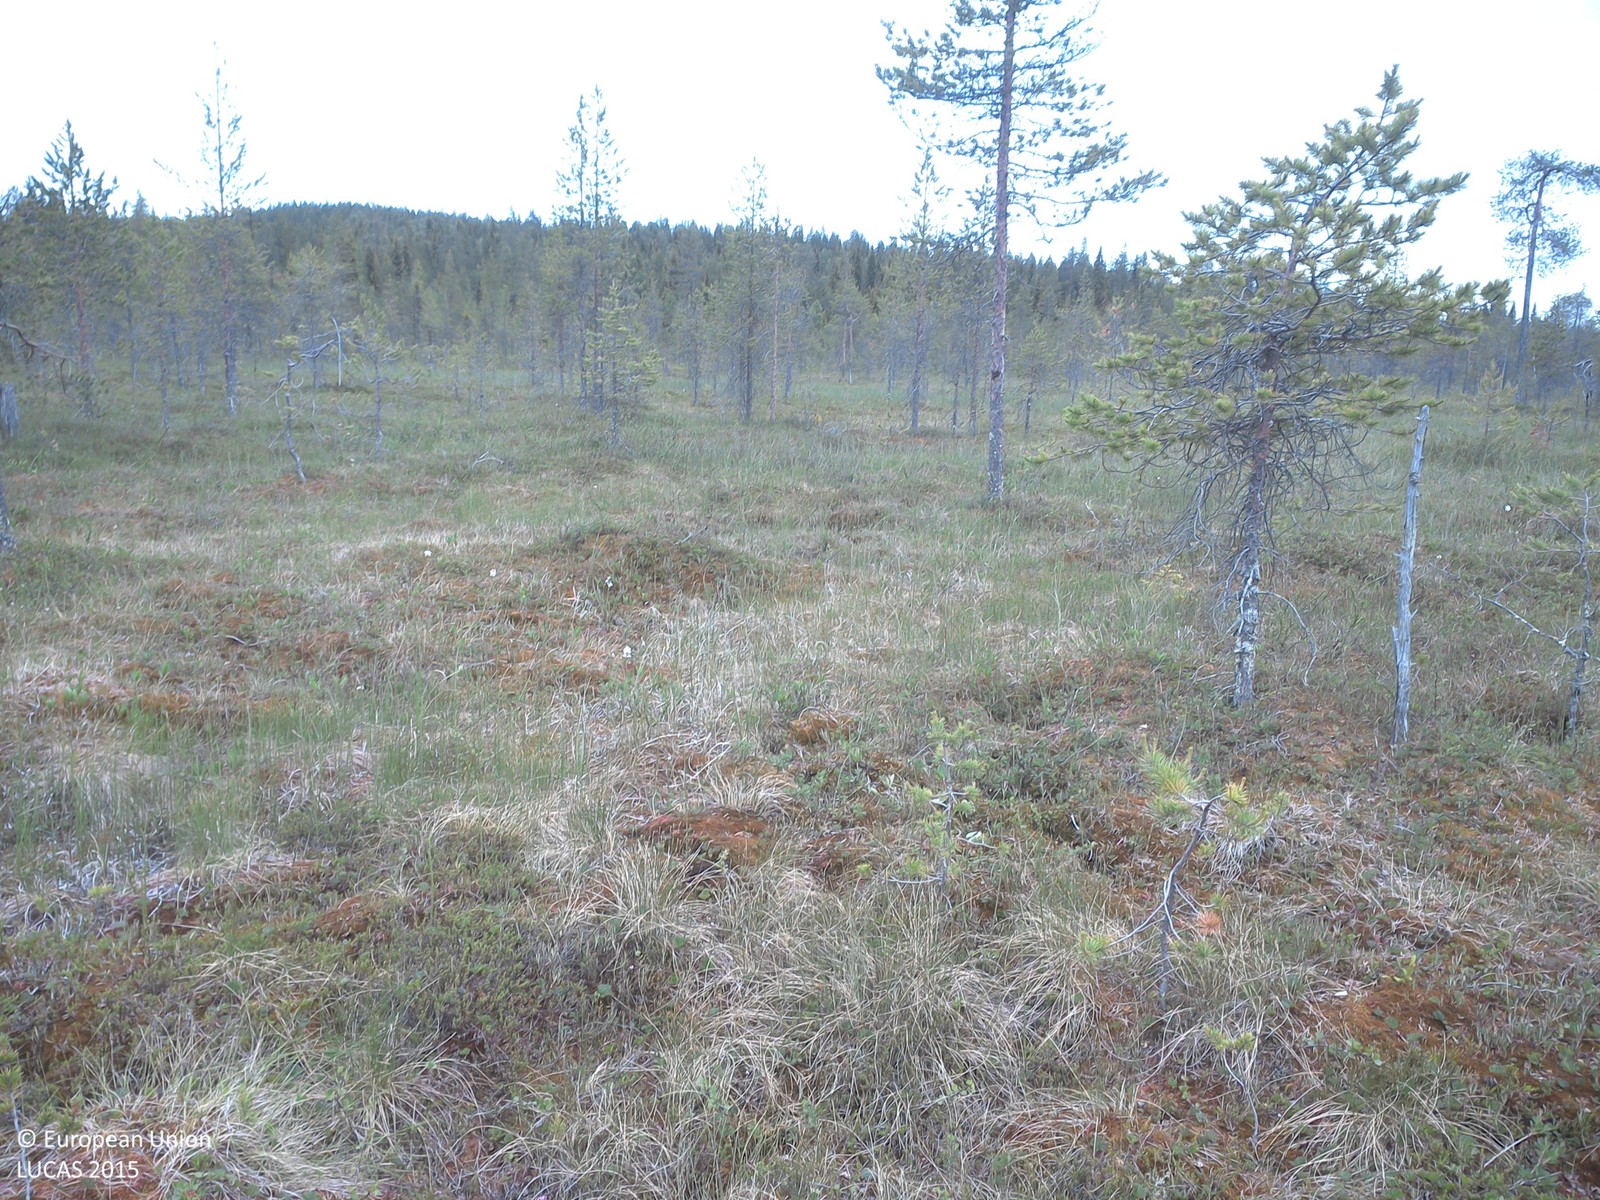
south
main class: Woodland
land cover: Pine dominated coniferous woodland
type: boreal forest
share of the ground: 10 - 25 %
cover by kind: lichens and mosses 45 %, herbaceous plants 25 %, shrubs 20 %, coniferous forest trees 10 %
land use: Amenities, museums, leisure
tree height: < 5 m
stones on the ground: < 10 %
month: July
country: SE
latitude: 66.8755
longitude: 23.0012
